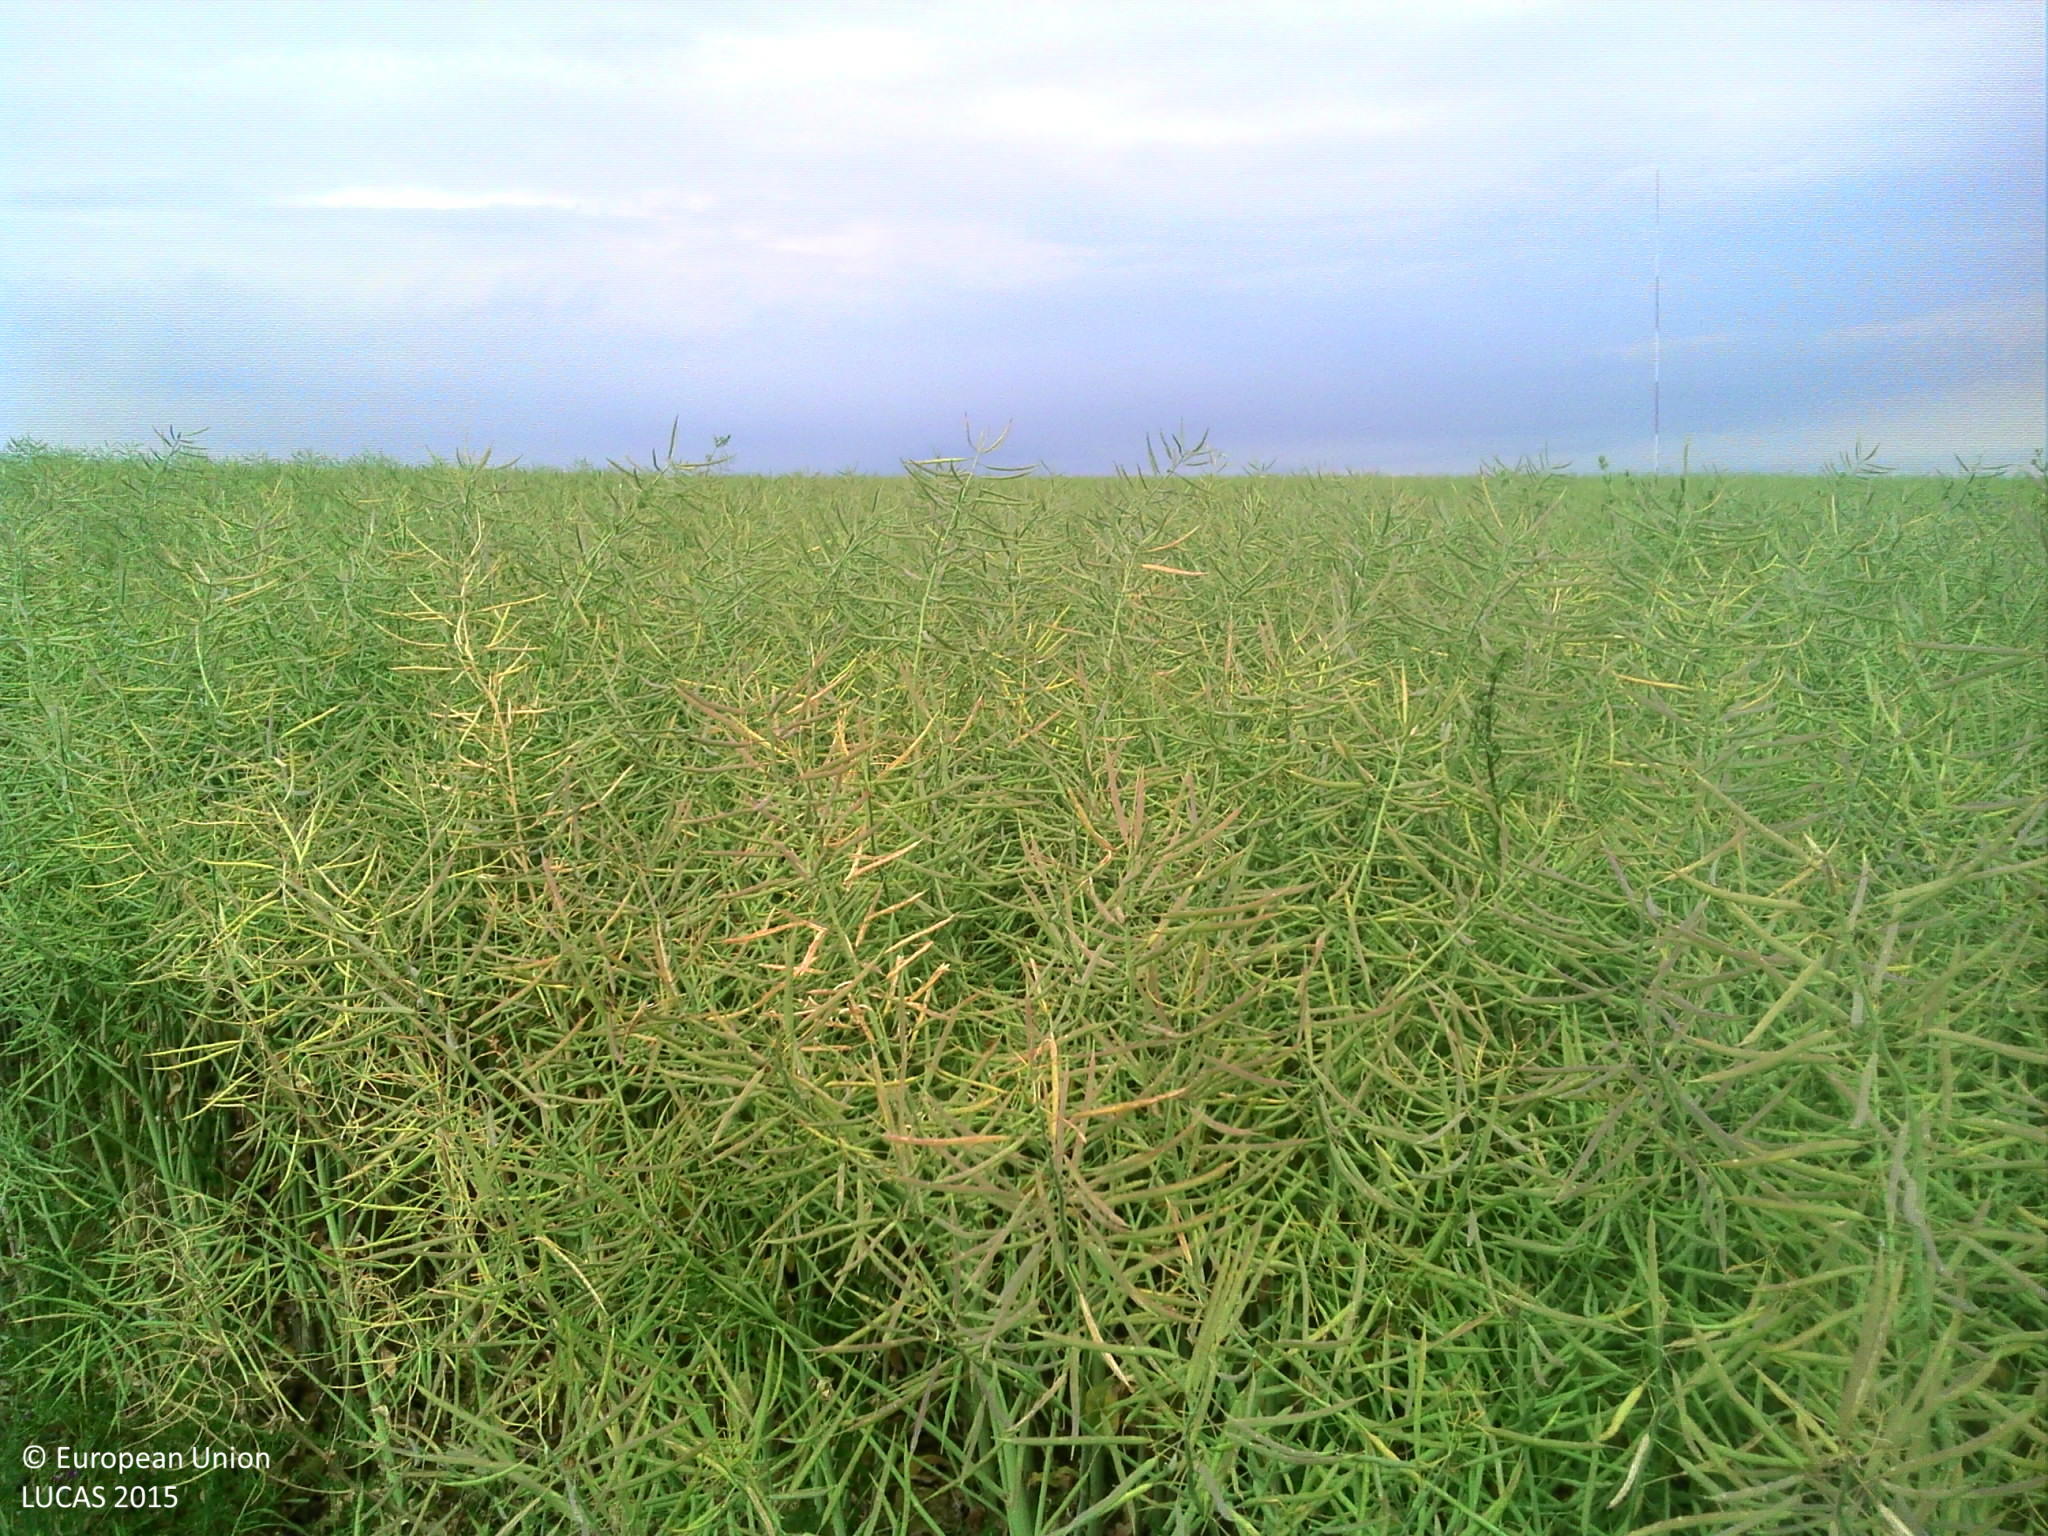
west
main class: Cropland
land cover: Rape and turnip rape
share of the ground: > 75 %
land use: Agriculture (excluding fallow land and kitchen gardens)
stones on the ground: 10 - 25 %
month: June
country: FR
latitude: 48.3788
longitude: 4.9624
